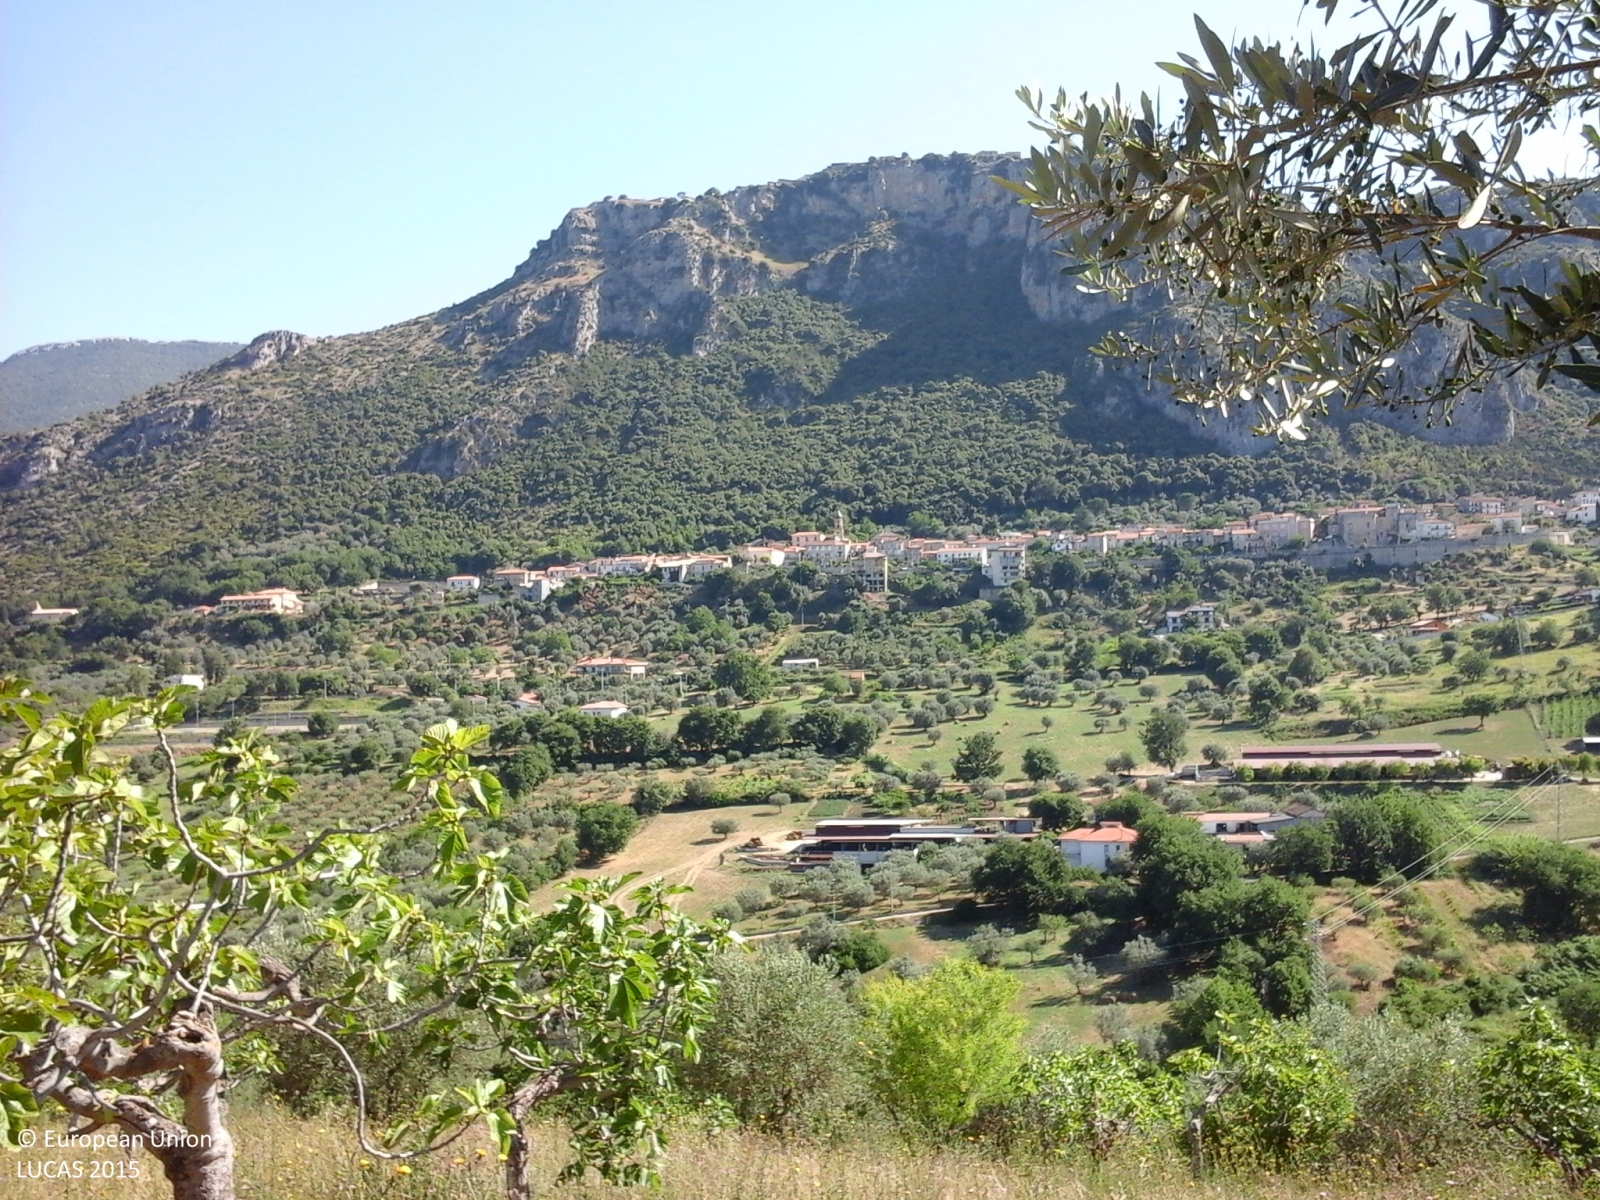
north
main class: Cropland
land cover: Olive groves
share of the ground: 25 - 50 %
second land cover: Other fruit trees and berries
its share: 25 - 50 %
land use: Agriculture (excluding fallow land and kitchen gardens)
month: June
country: IT
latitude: 40.3884
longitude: 15.1024
